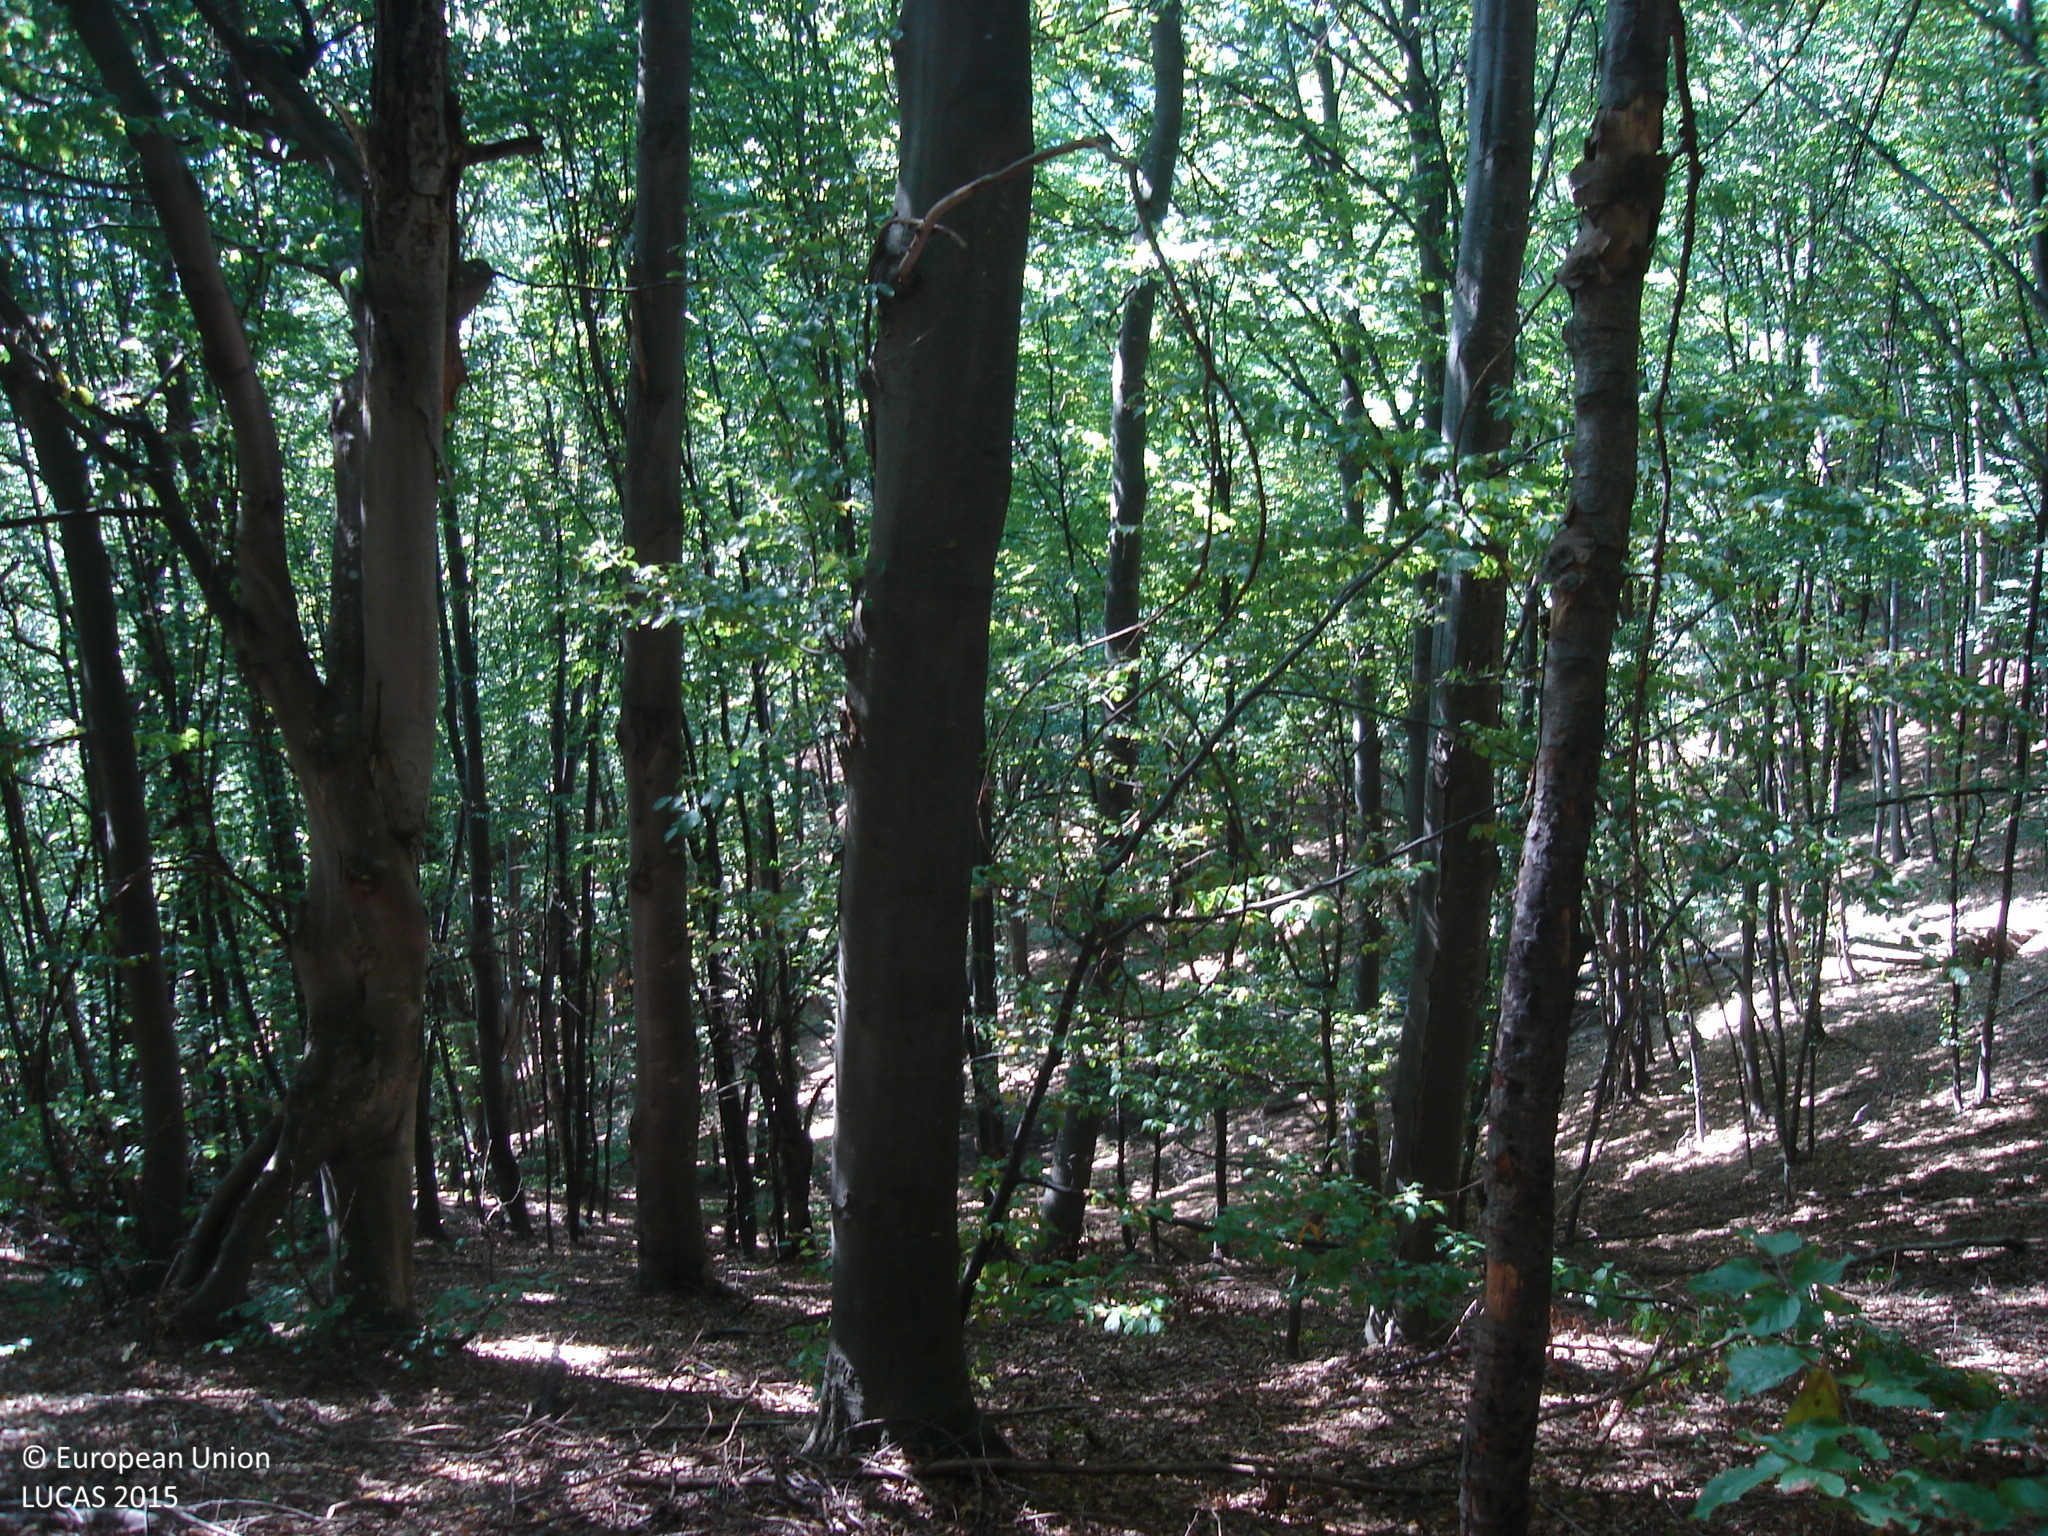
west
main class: Woodland
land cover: Broadleaved woodland
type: beech forest
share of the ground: > 75 %
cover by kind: broadleaved forest trees 80 %, consolidated bare surface 20 %
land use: Forestry
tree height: > 5 m
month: September
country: BG
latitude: 42.8108
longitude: 23.9995
